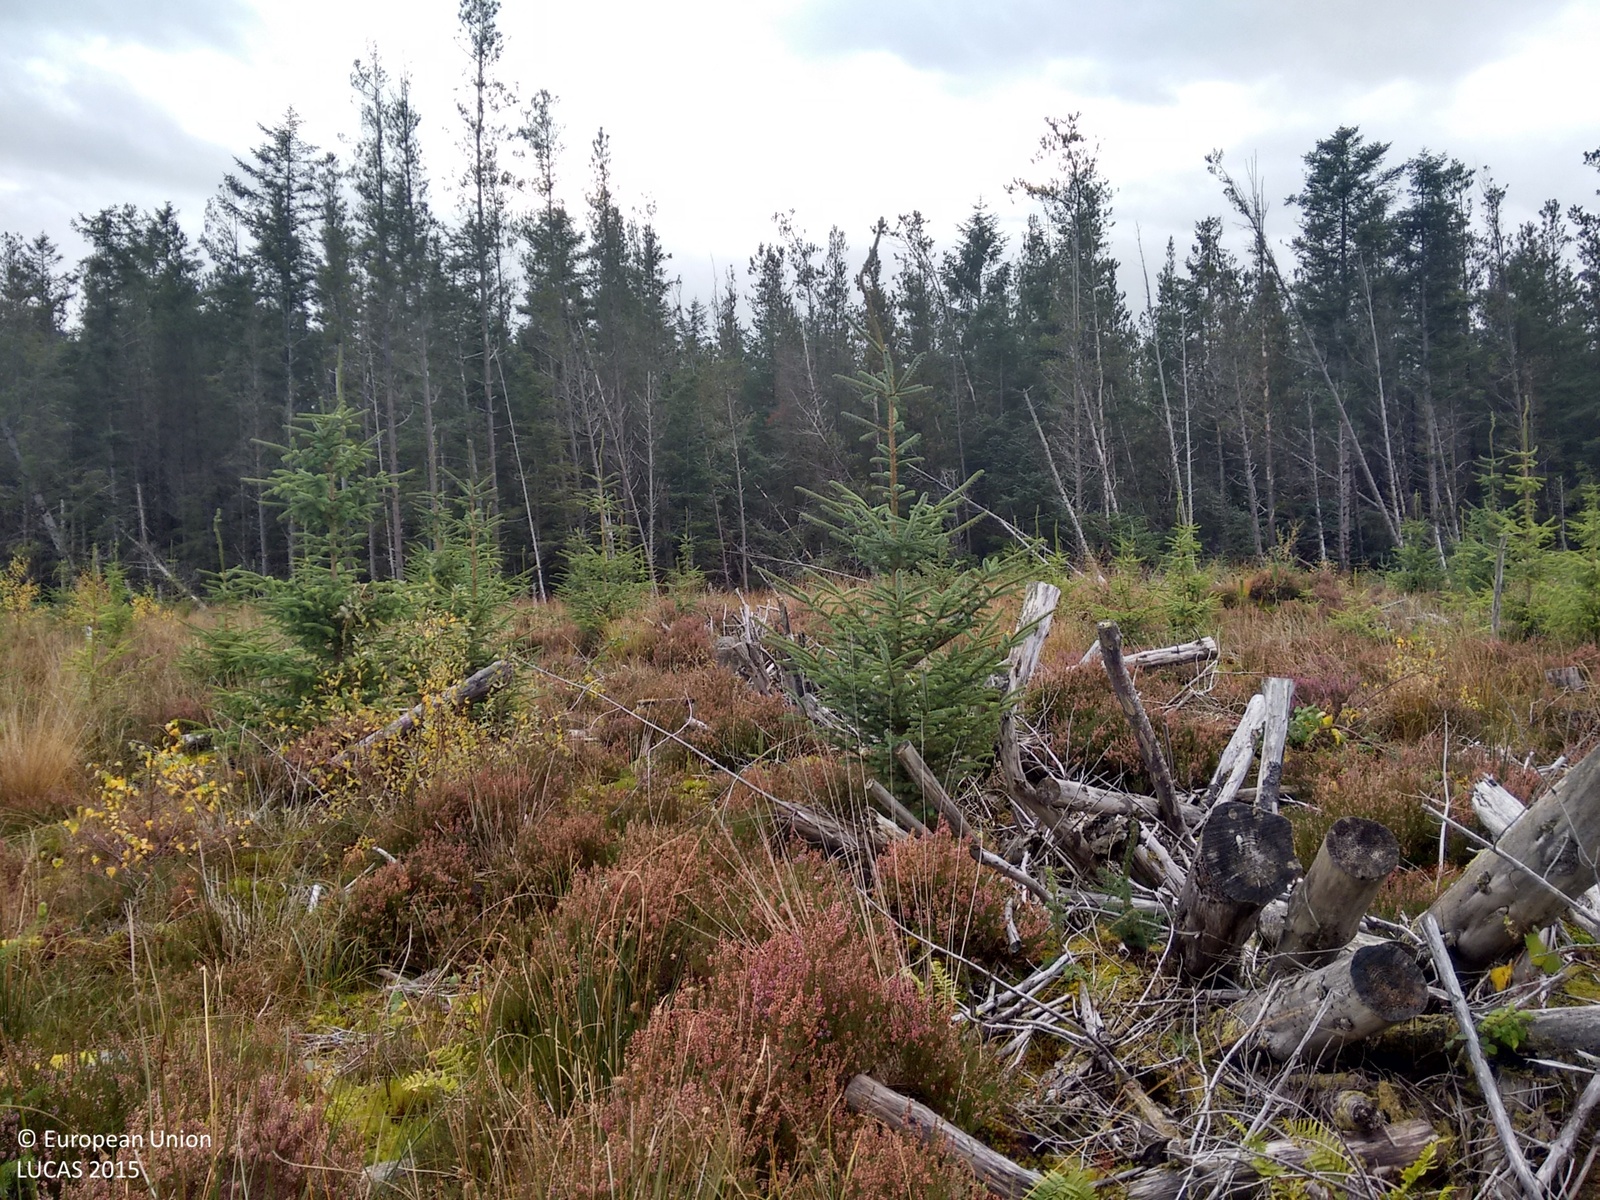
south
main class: Woodland
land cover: Other mixed woodland
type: exotic forest
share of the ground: > 75 %
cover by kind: coniferous forest trees 40 %, broadleaved forest trees 20 %, shrubs 15 %, lichens and mosses 15 %, herbaceous plants 5 %
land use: Forestry
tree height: < 5 m
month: October
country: GB
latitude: 56.4235
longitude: -5.7063
